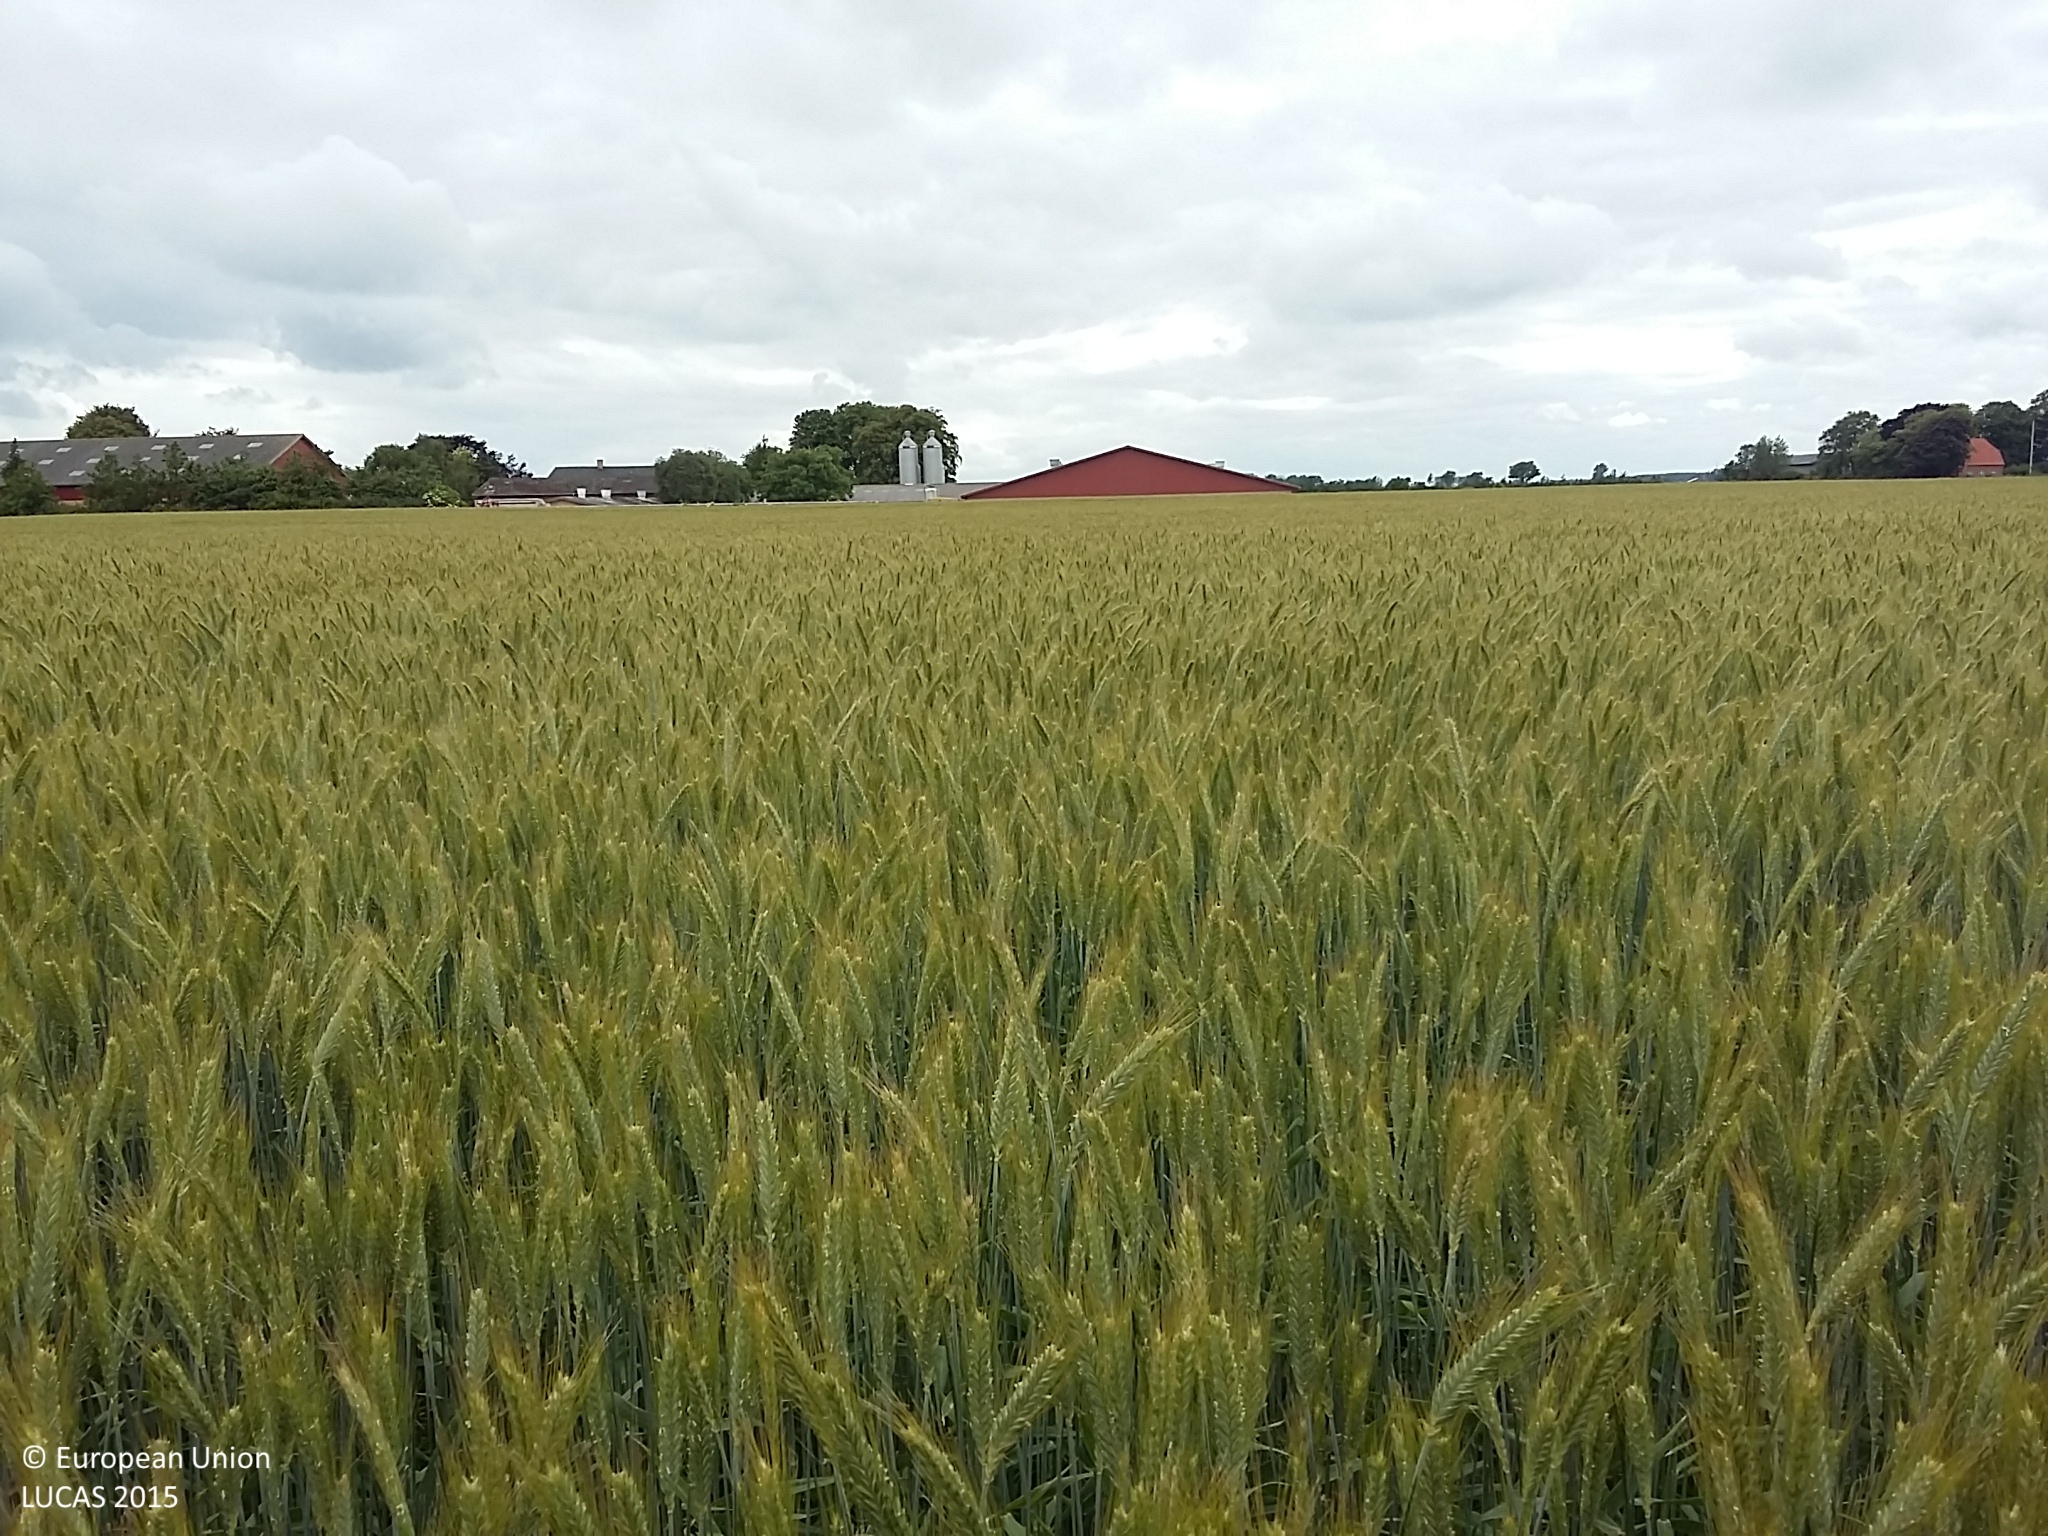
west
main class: Cropland
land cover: Rye
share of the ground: > 75 %
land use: Agriculture (excluding fallow land and kitchen gardens)
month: June
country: DK
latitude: 54.6853
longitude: 11.6277
